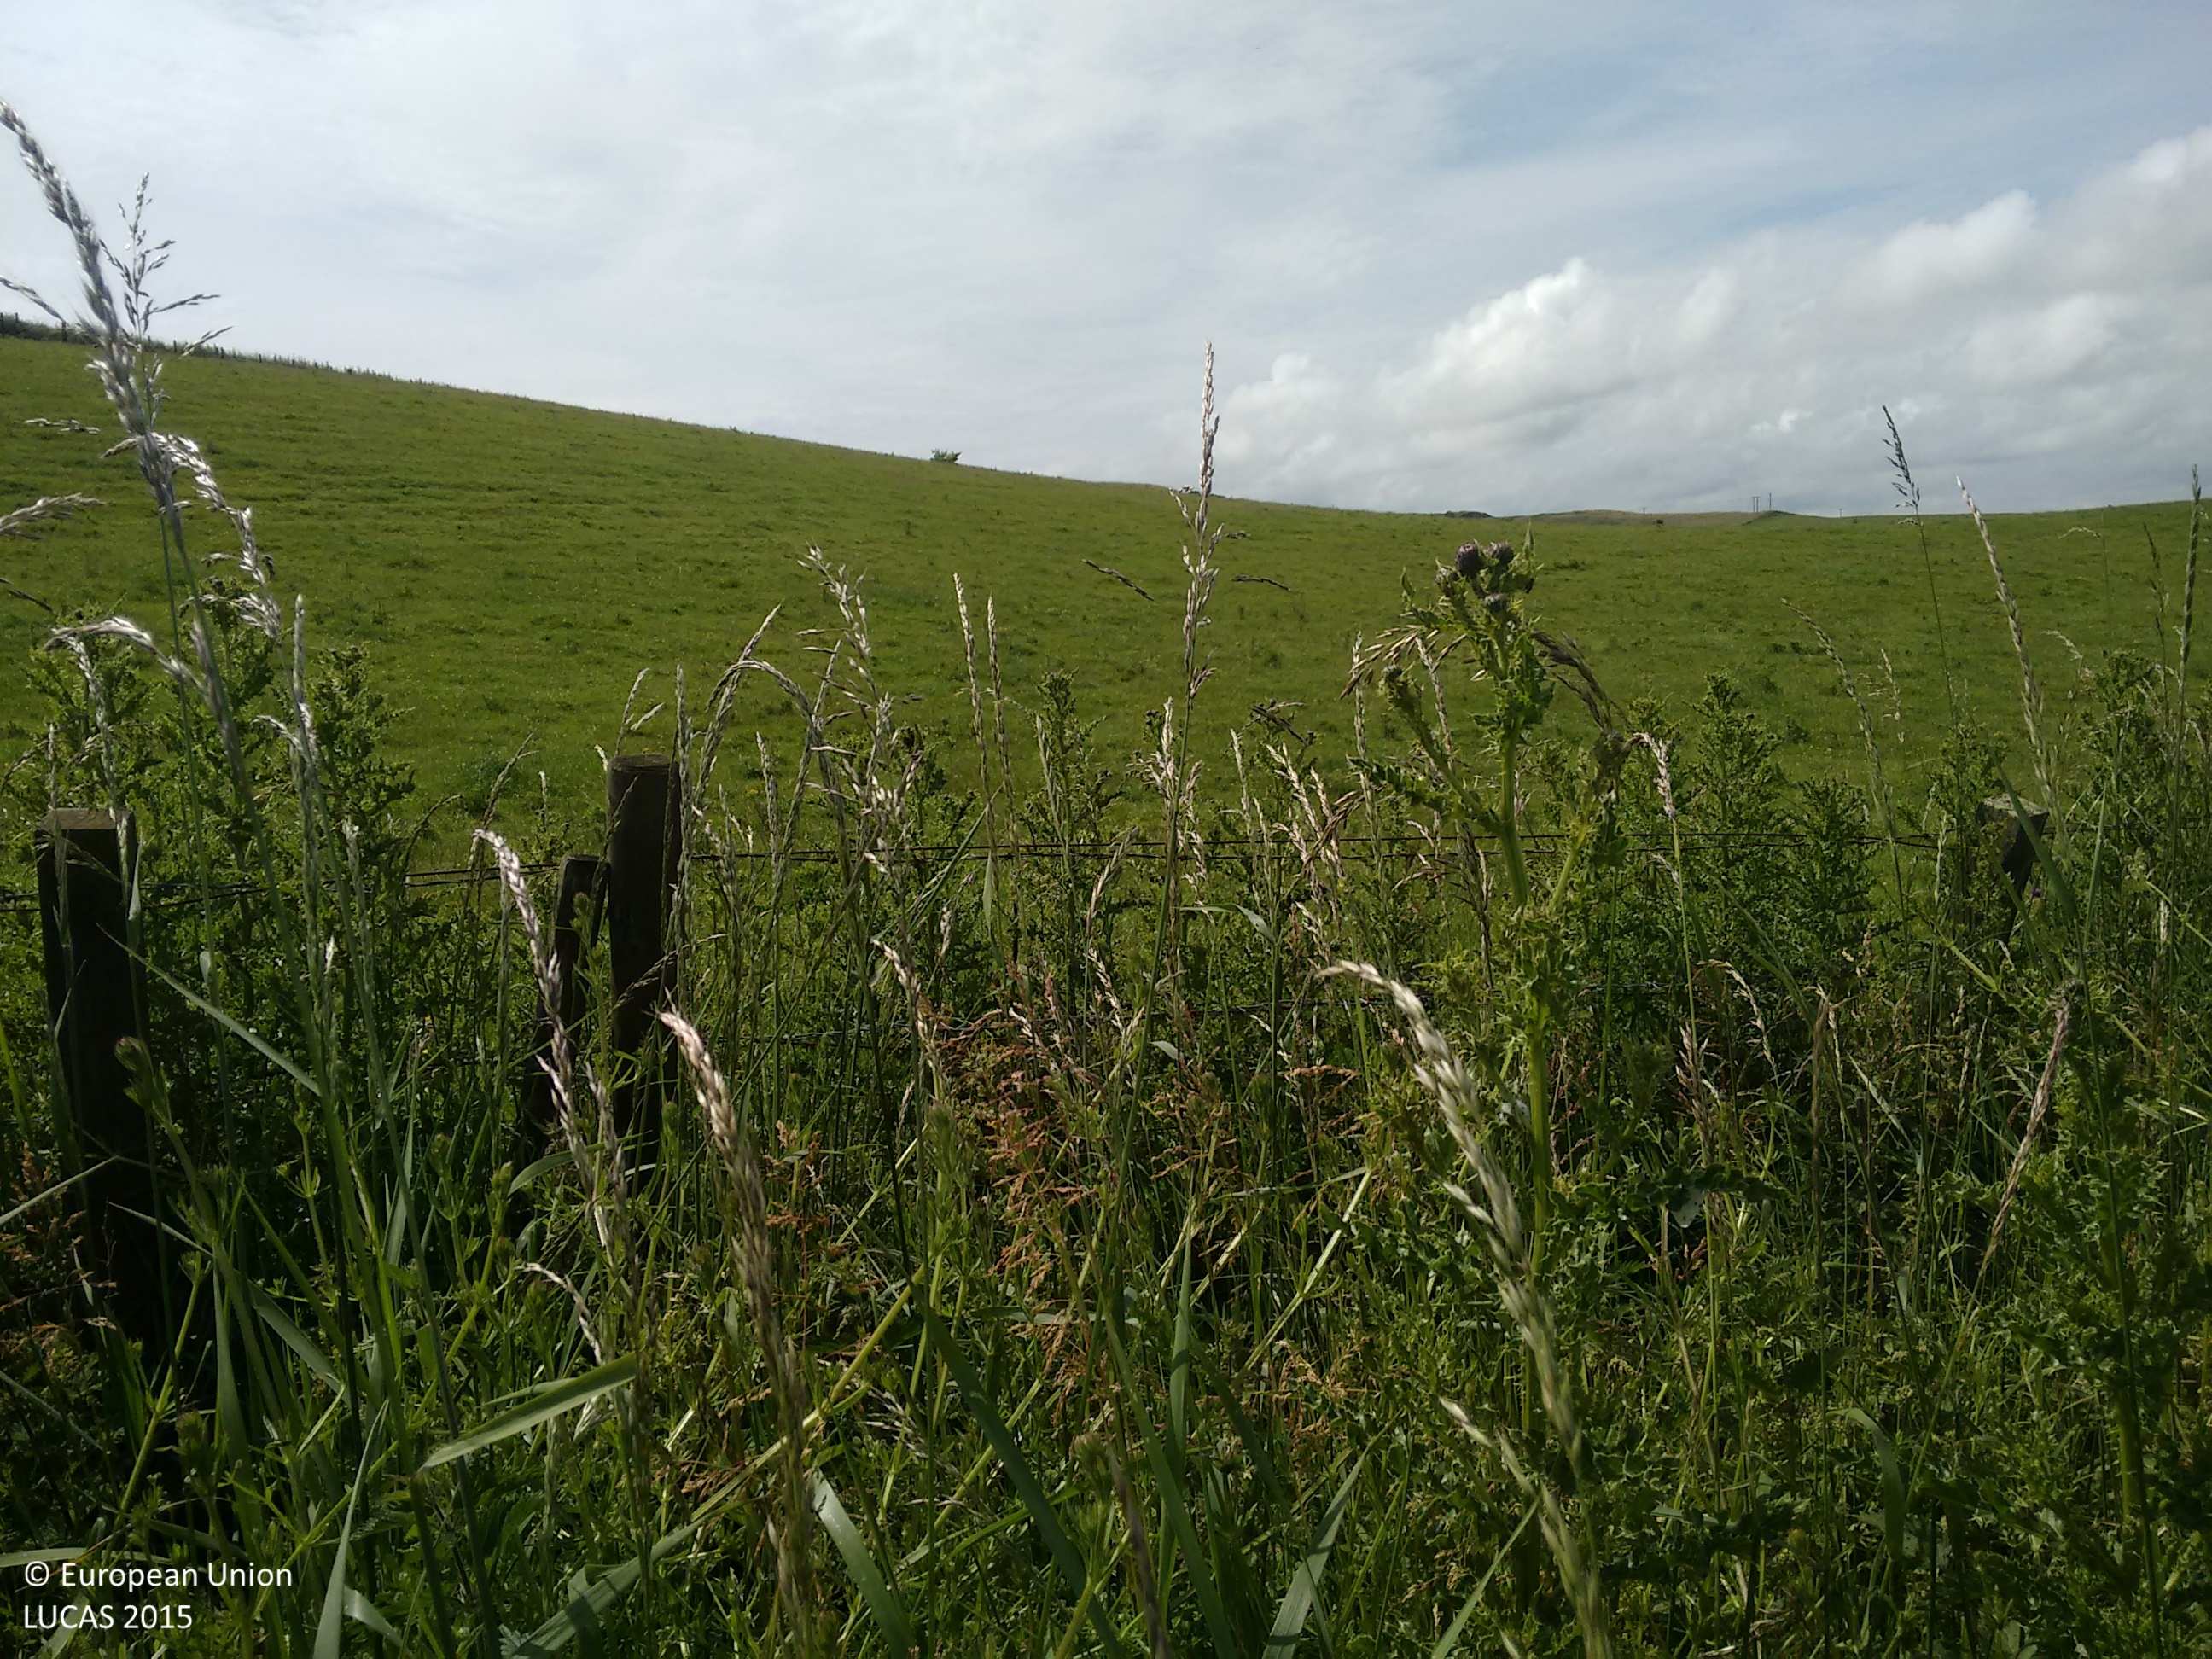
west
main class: Cropland
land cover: Barley
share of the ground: > 75 %
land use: Agriculture (excluding fallow land and kitchen gardens)
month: July
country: GB
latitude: 56.0825
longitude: -3.2323
